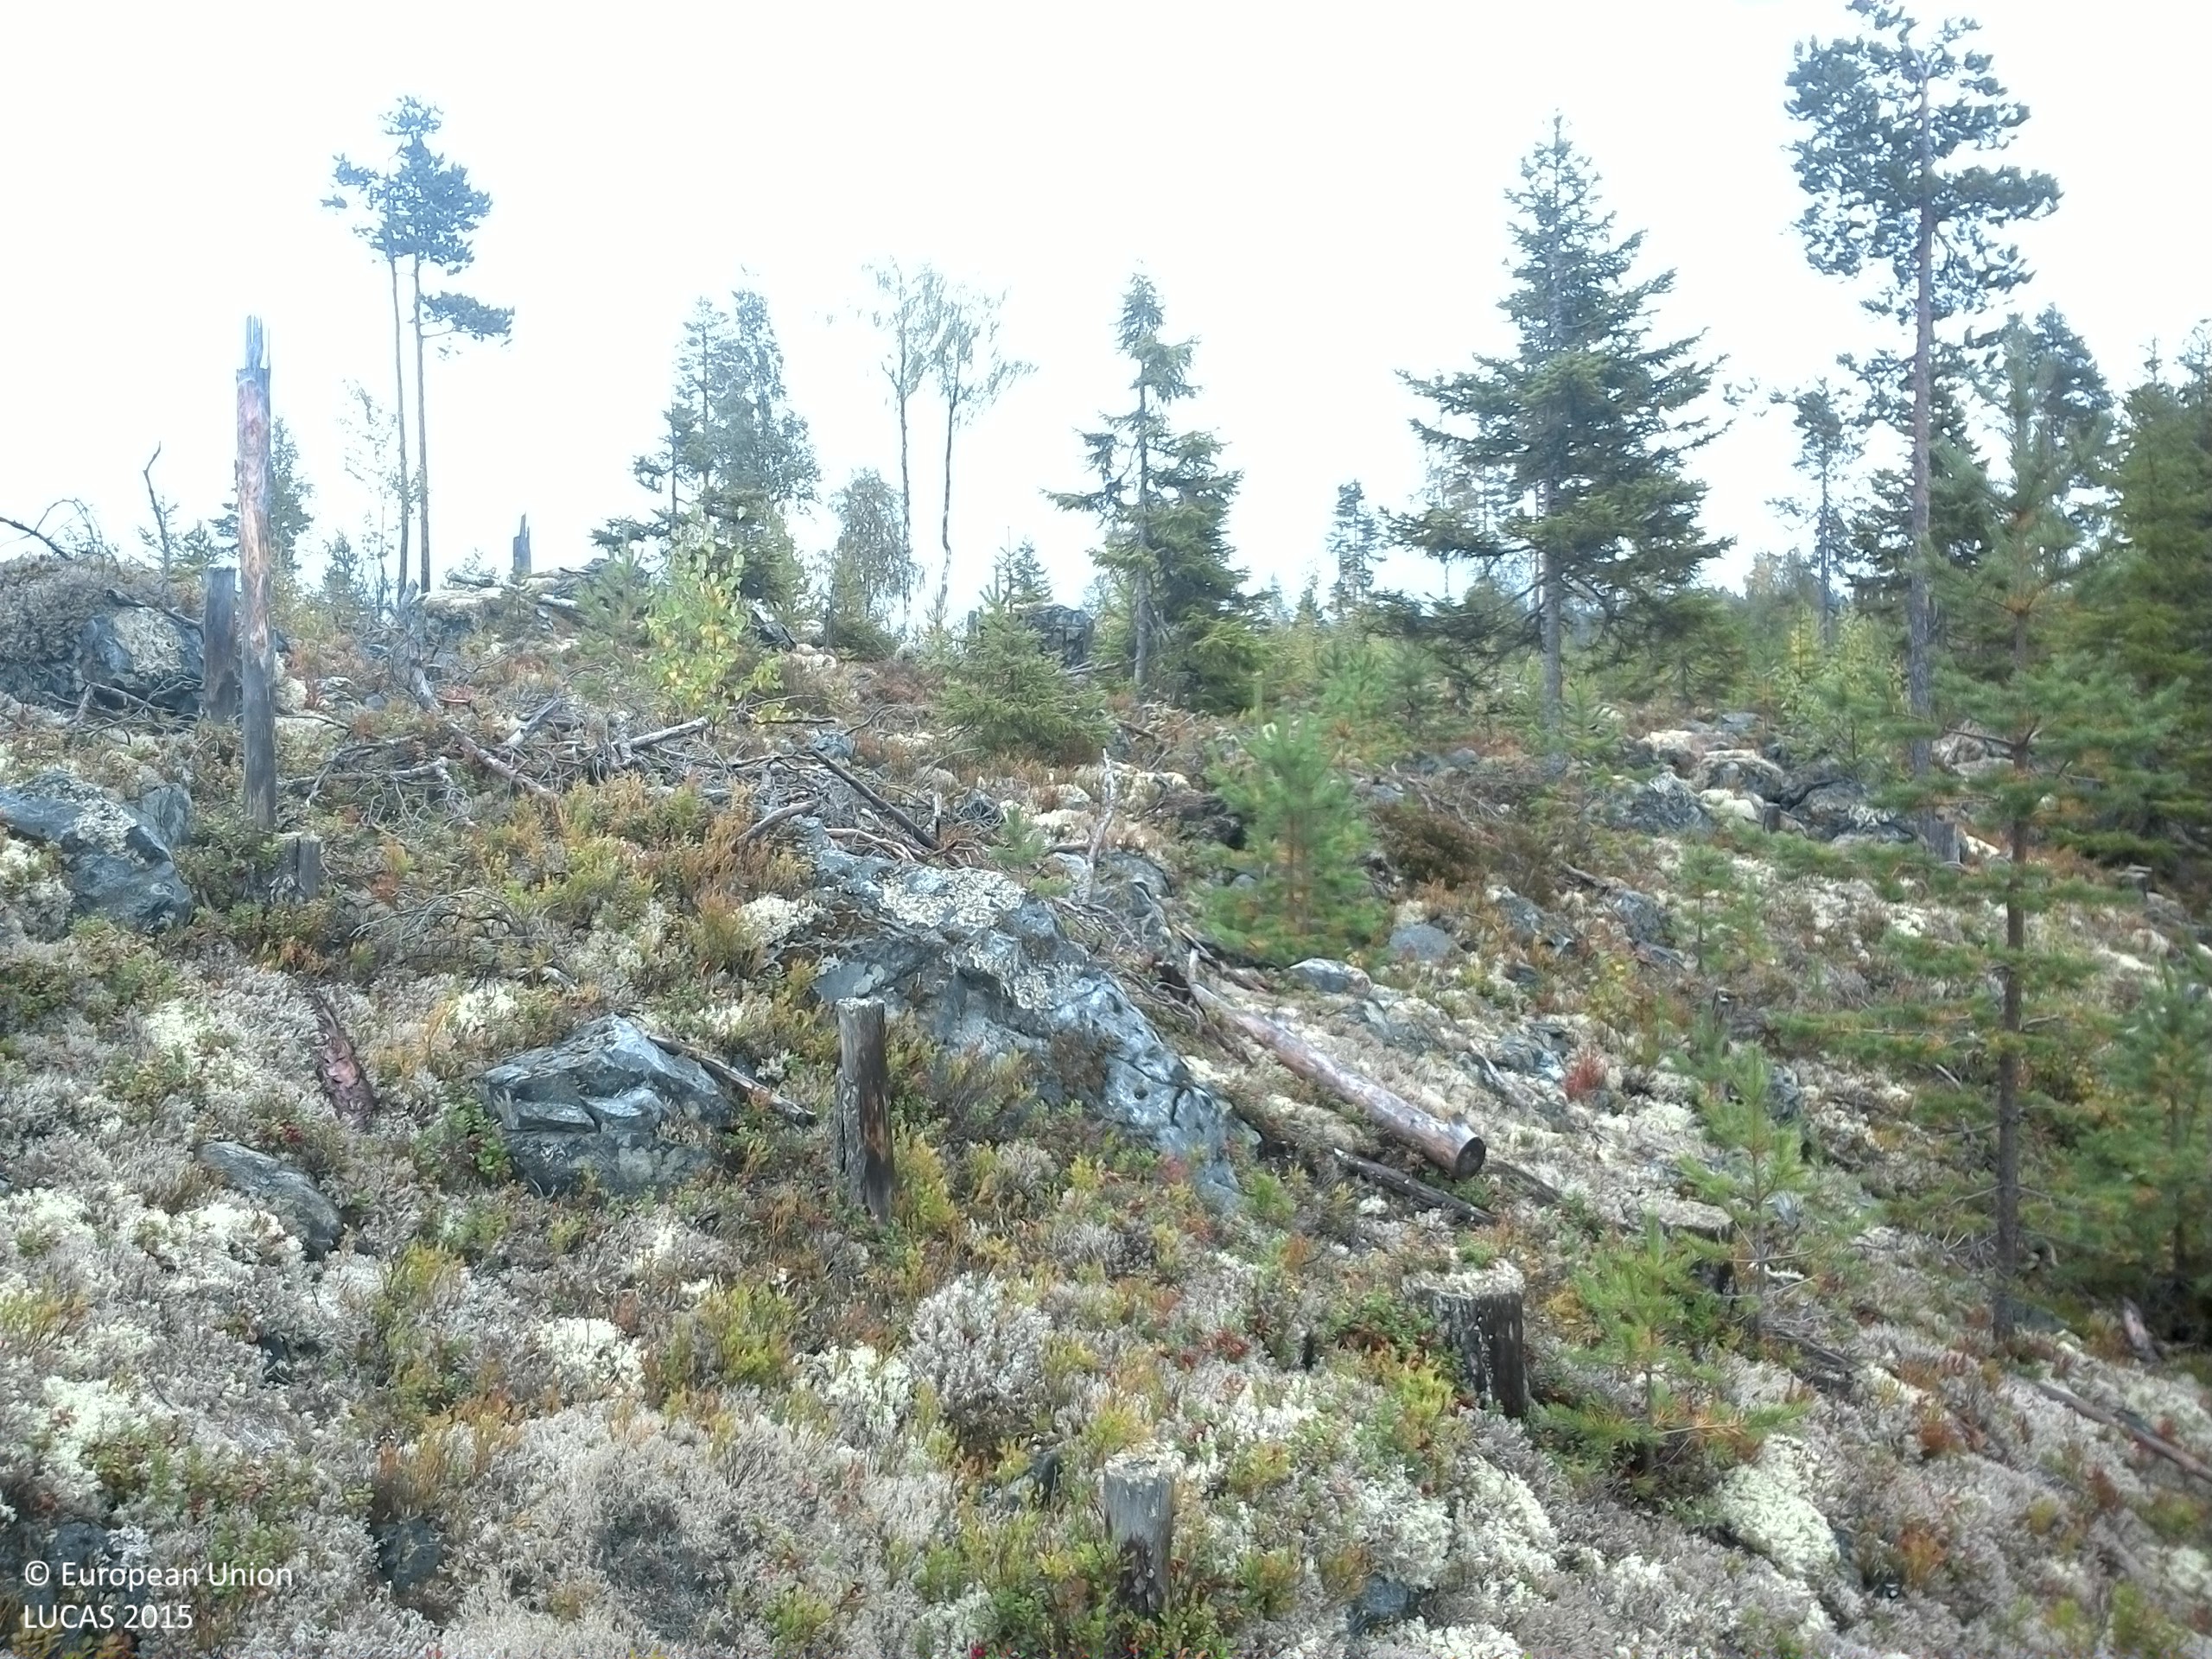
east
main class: Woodland
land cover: Pine dominated mixed woodland
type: boreal forest
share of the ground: 10 - 25 %
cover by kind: shrubs 55 %, lichens and mosses 20 %, coniferous forest trees 10 %, consolidated bare surface 10 %, broadleaved forest trees 5 %
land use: Forestry
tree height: < 5 m
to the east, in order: Pine dominated mixed woodland; Shrubland without tree cover; Pine dominated coniferous woodland; Other mixed woodland; Pine dominated coniferous woodland
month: September
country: SE
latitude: 61.6935
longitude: 15.1443
